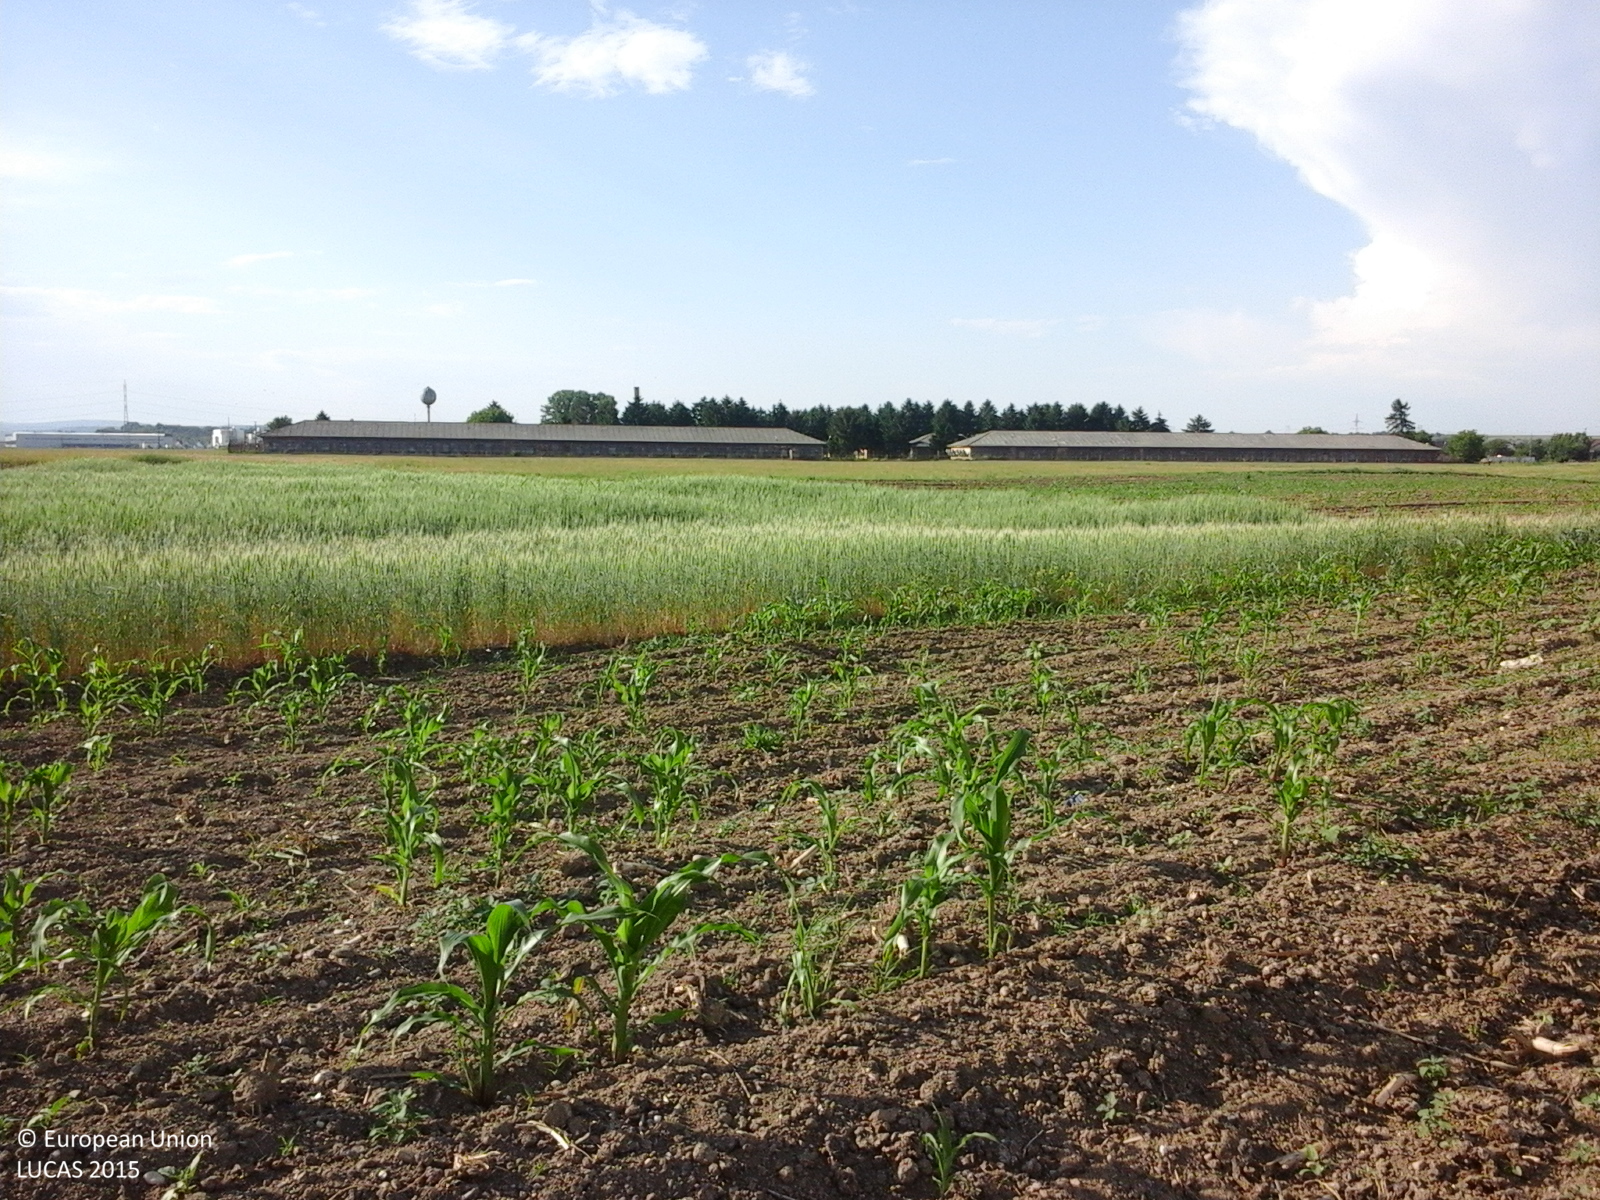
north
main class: Cropland
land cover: Maize
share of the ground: 10 - 25 %
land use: Agriculture (excluding fallow land and kitchen gardens)
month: June
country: RO
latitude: 46.6162
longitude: 26.8728
